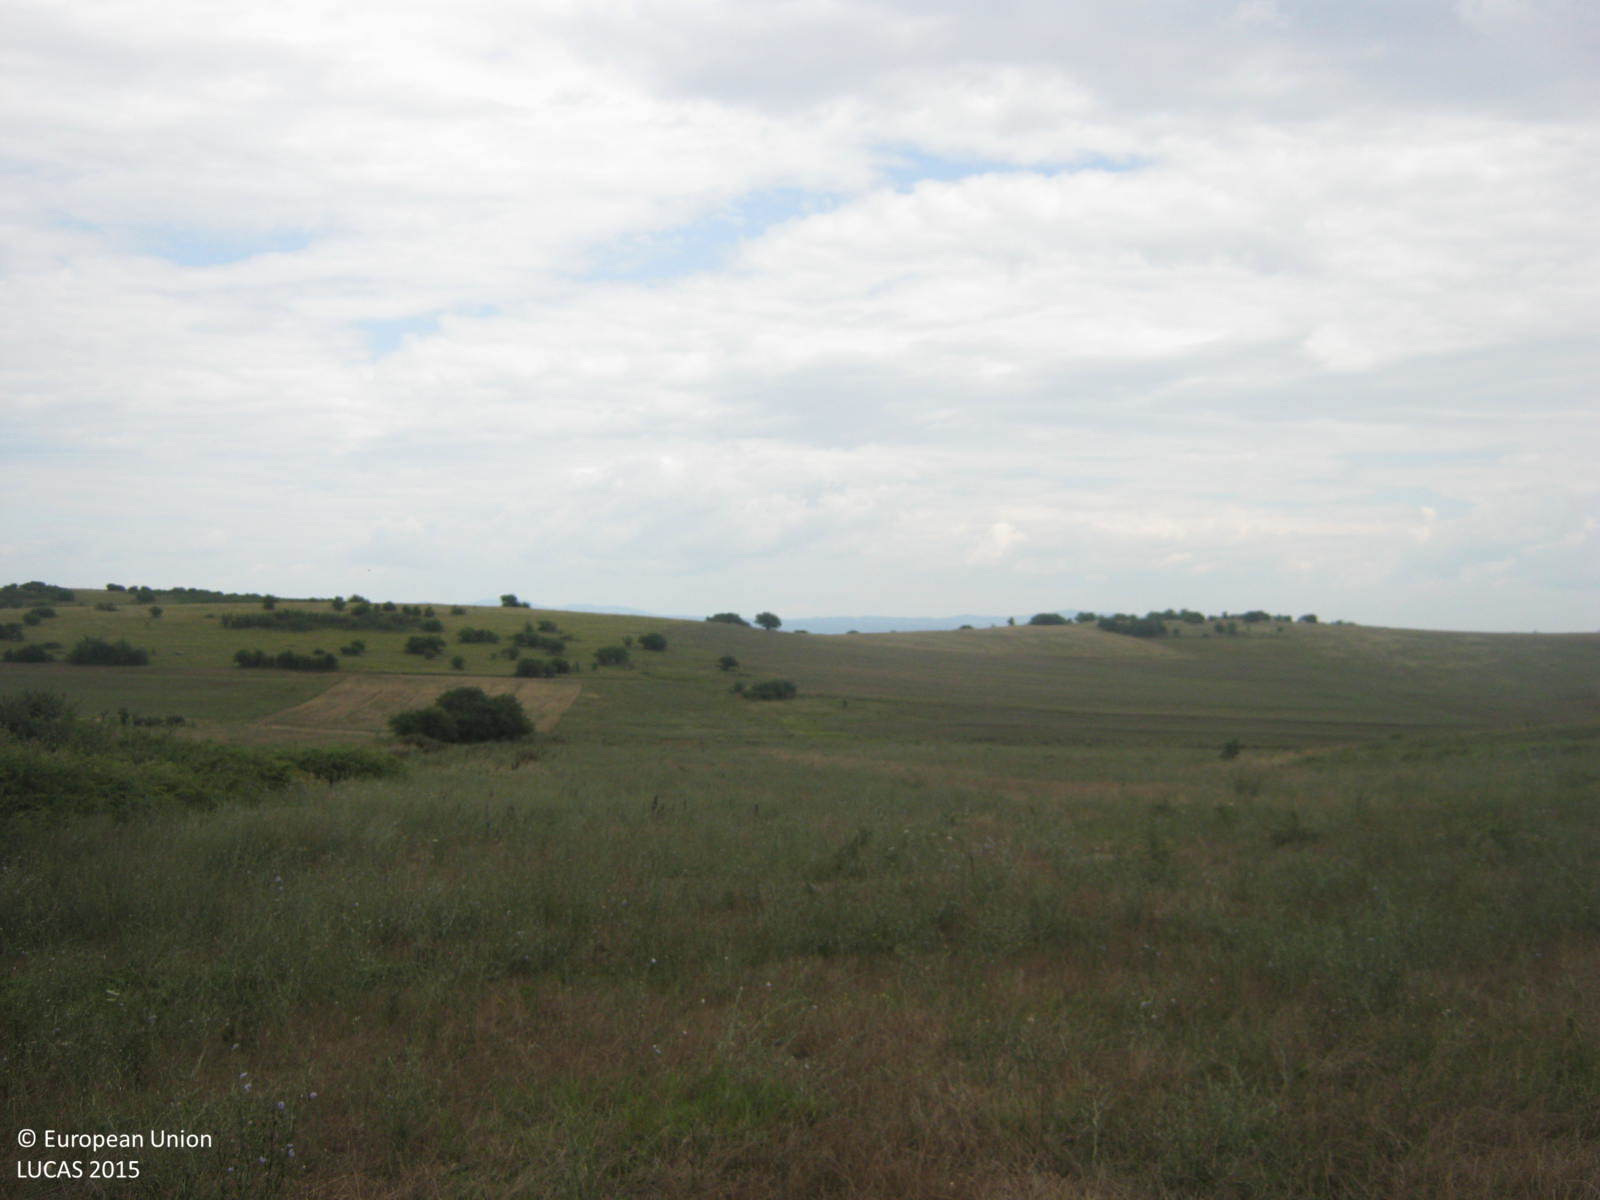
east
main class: Grassland
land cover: Spontaneously vegetated surfaces
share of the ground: > 75 %
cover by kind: herbaceous plants 100 %
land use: Agriculture (excluding fallow land and kitchen gardens)
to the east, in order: Spontaneously vegetated surfaces; Common wheat; Shrubland without tree cover; Grassland without tree/shrub cover
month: July
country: GR
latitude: 40.9697
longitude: 22.7353
